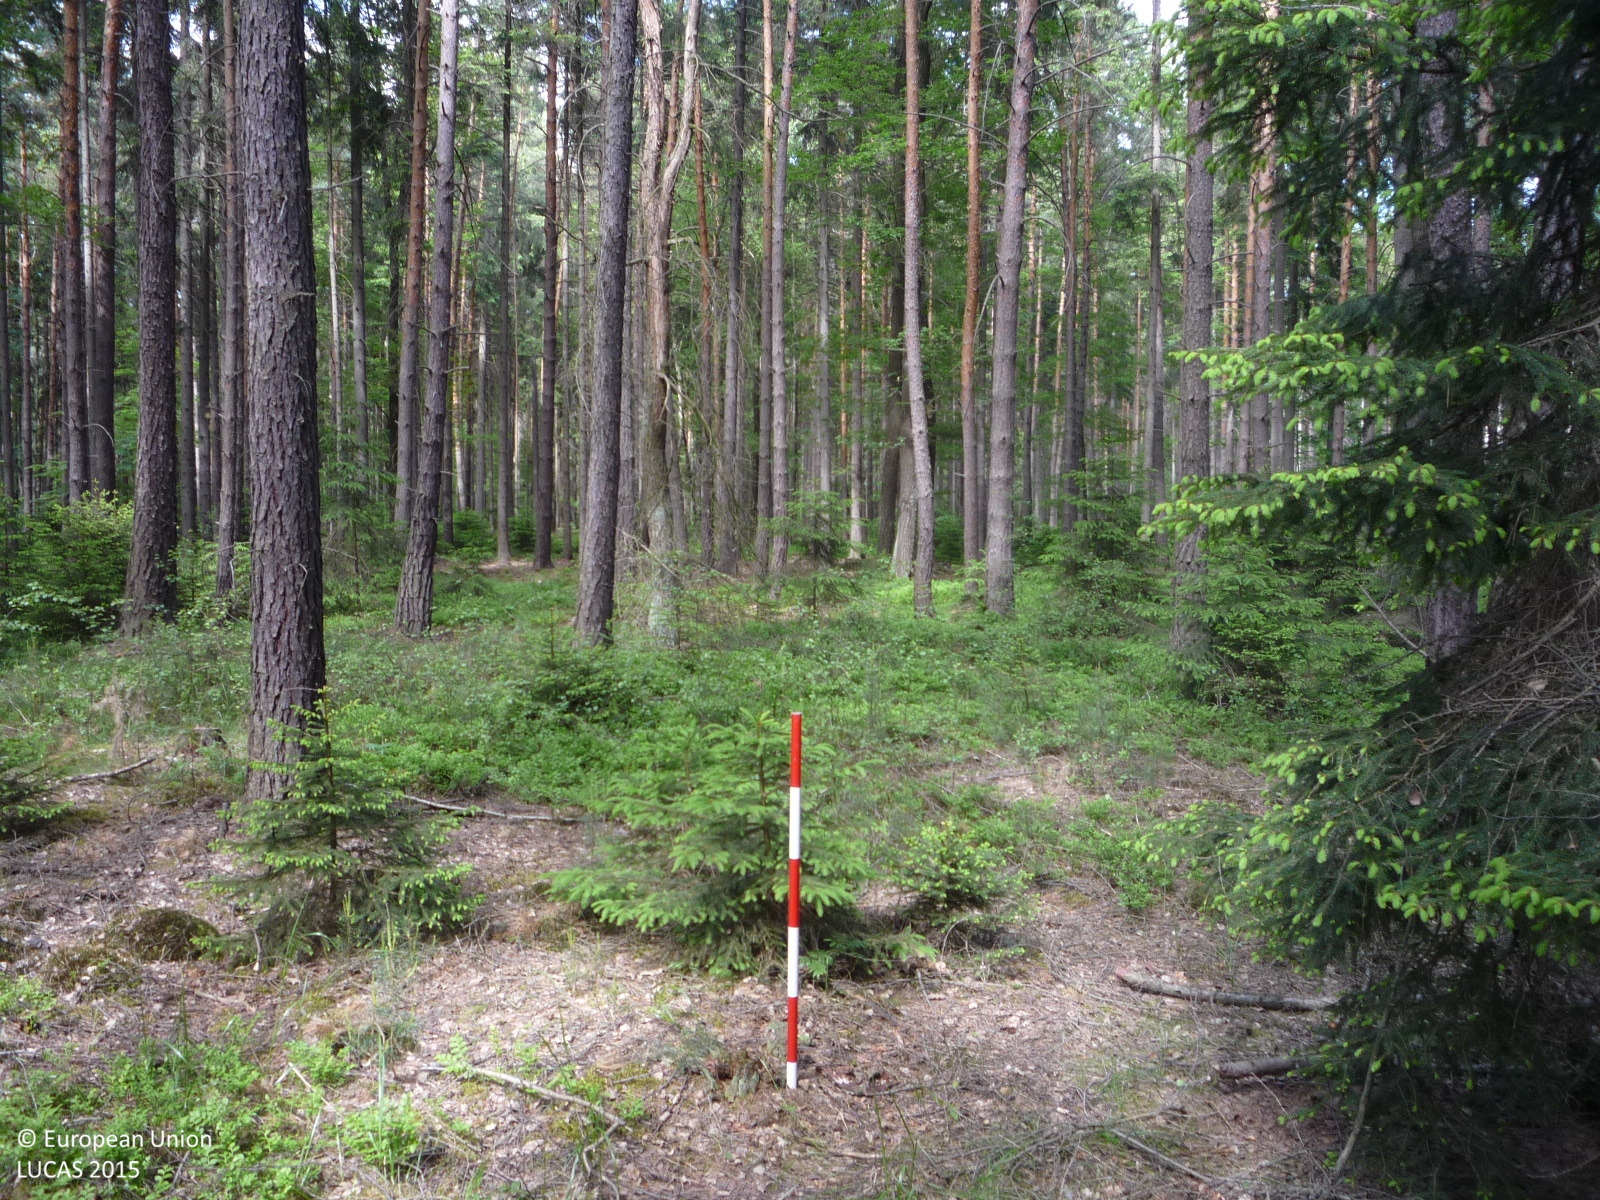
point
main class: Woodland
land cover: Pine dominated coniferous woodland
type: hemiboreal forest and nemoral coniferous forest and mixed broadleaved-coniferous forest
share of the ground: > 75 %
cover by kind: coniferous forest trees 90 %, broadleaved forest trees 10 %
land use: Forestry
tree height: > 5 m
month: June
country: CZ
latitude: 50.2450
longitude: 13.8570
